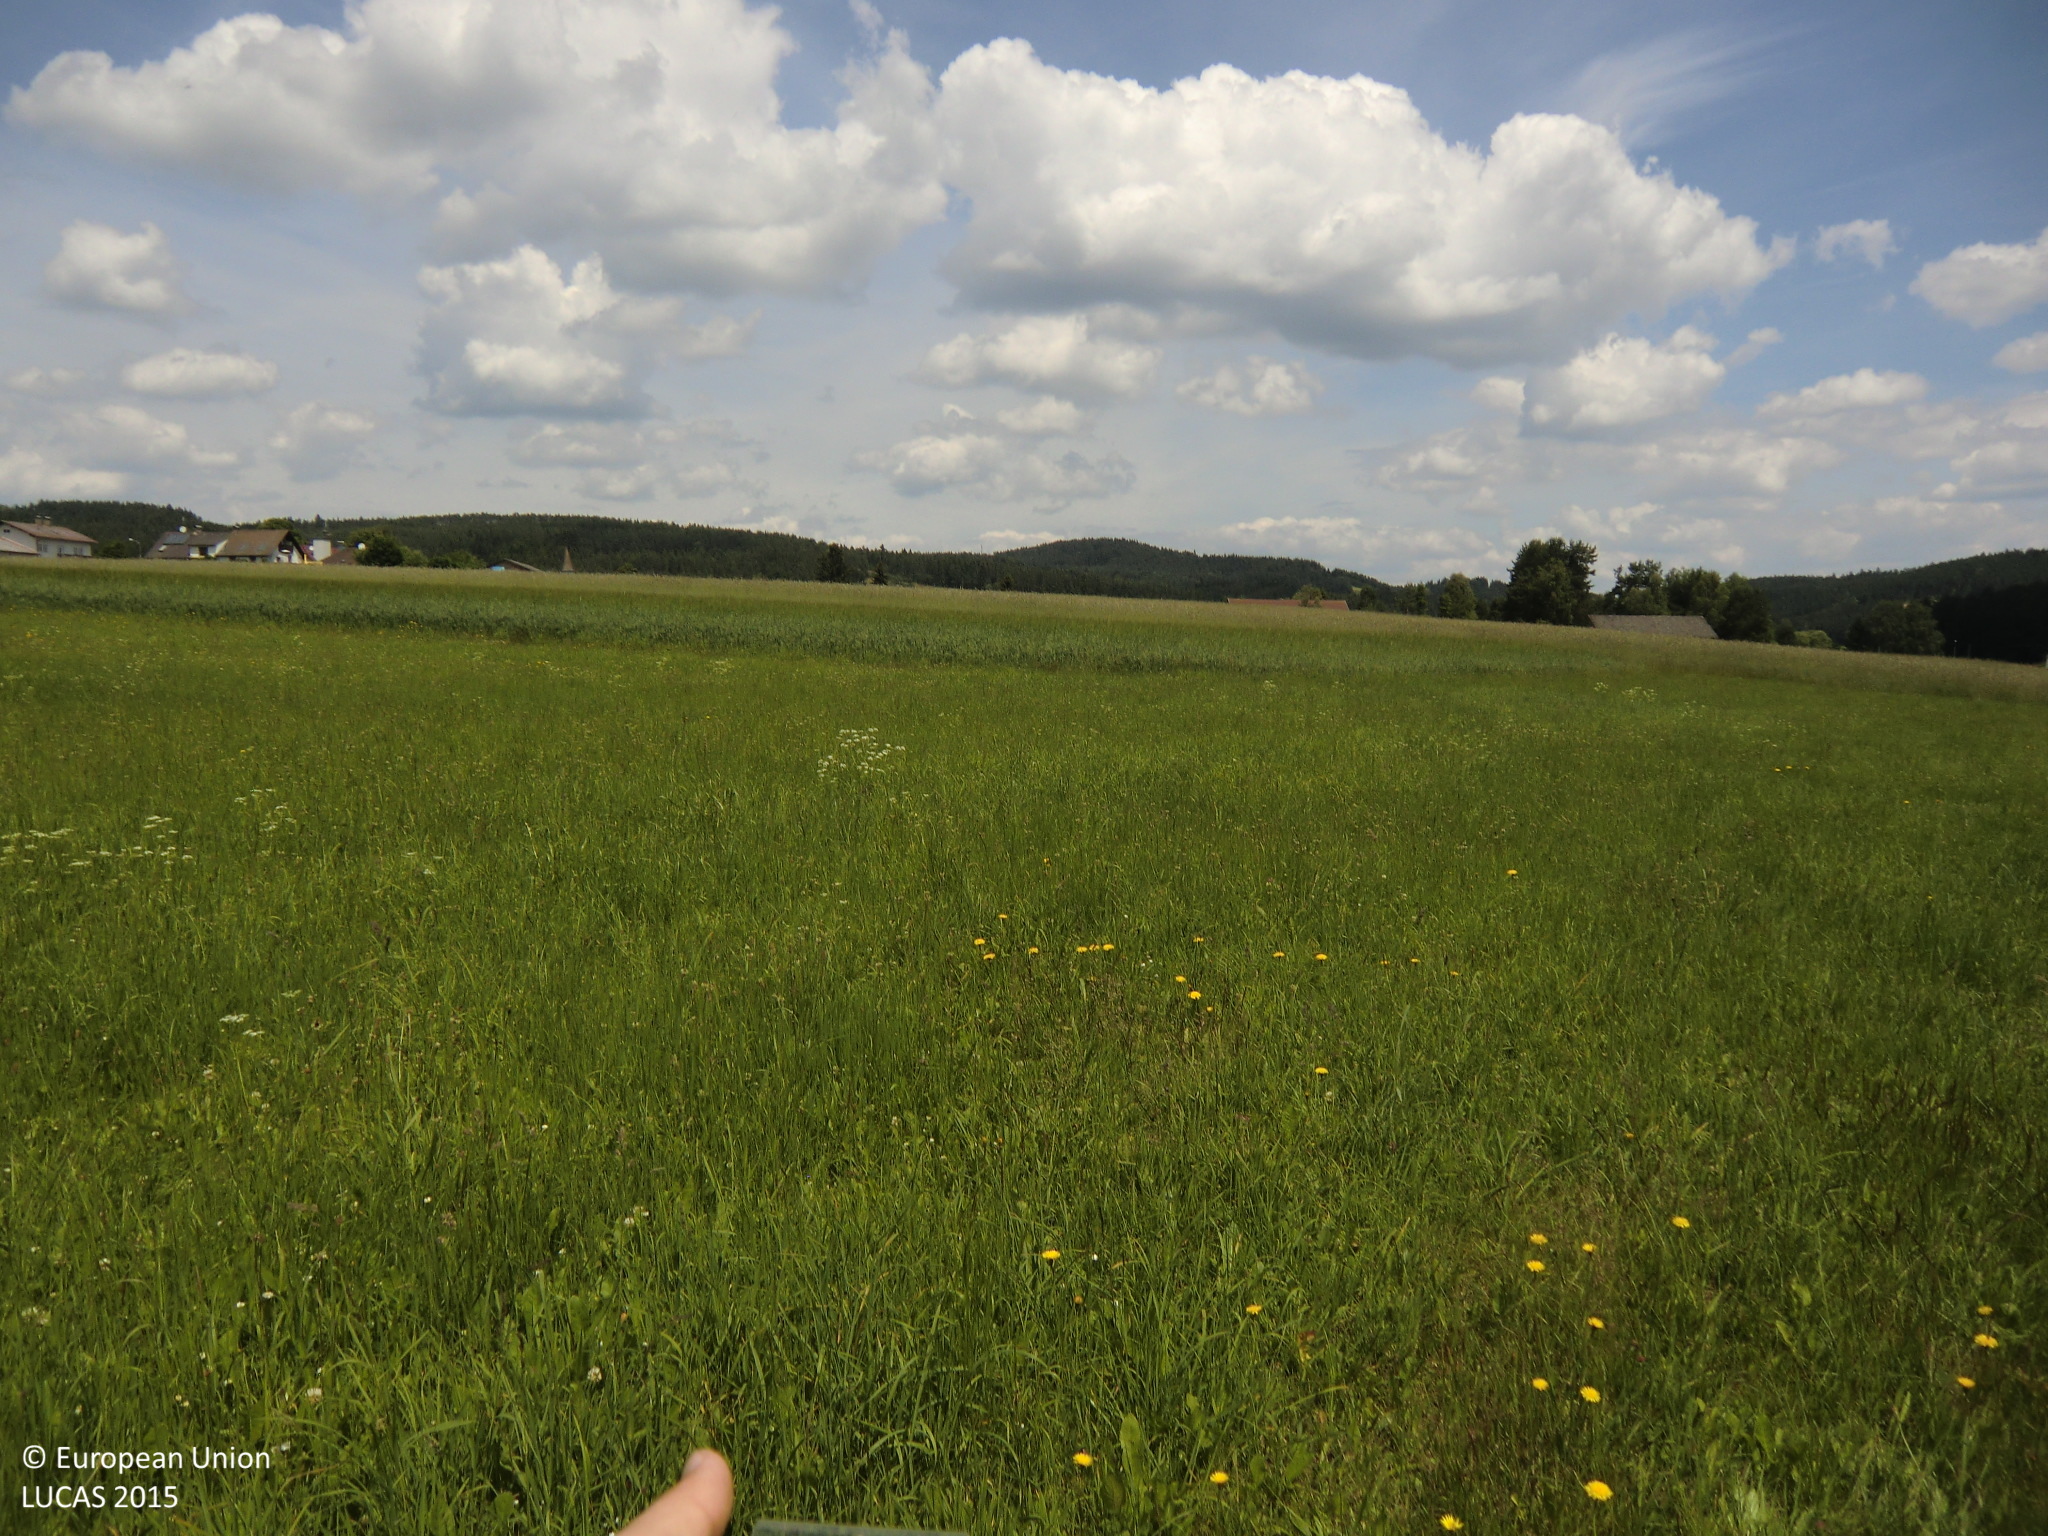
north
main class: Grassland
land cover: Grassland without tree/shrub cover
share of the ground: > 75 %
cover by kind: herbaceous plants 100 %
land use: Agriculture (excluding fallow land and kitchen gardens)
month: June
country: AT
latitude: 48.4865
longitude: 15.0484
